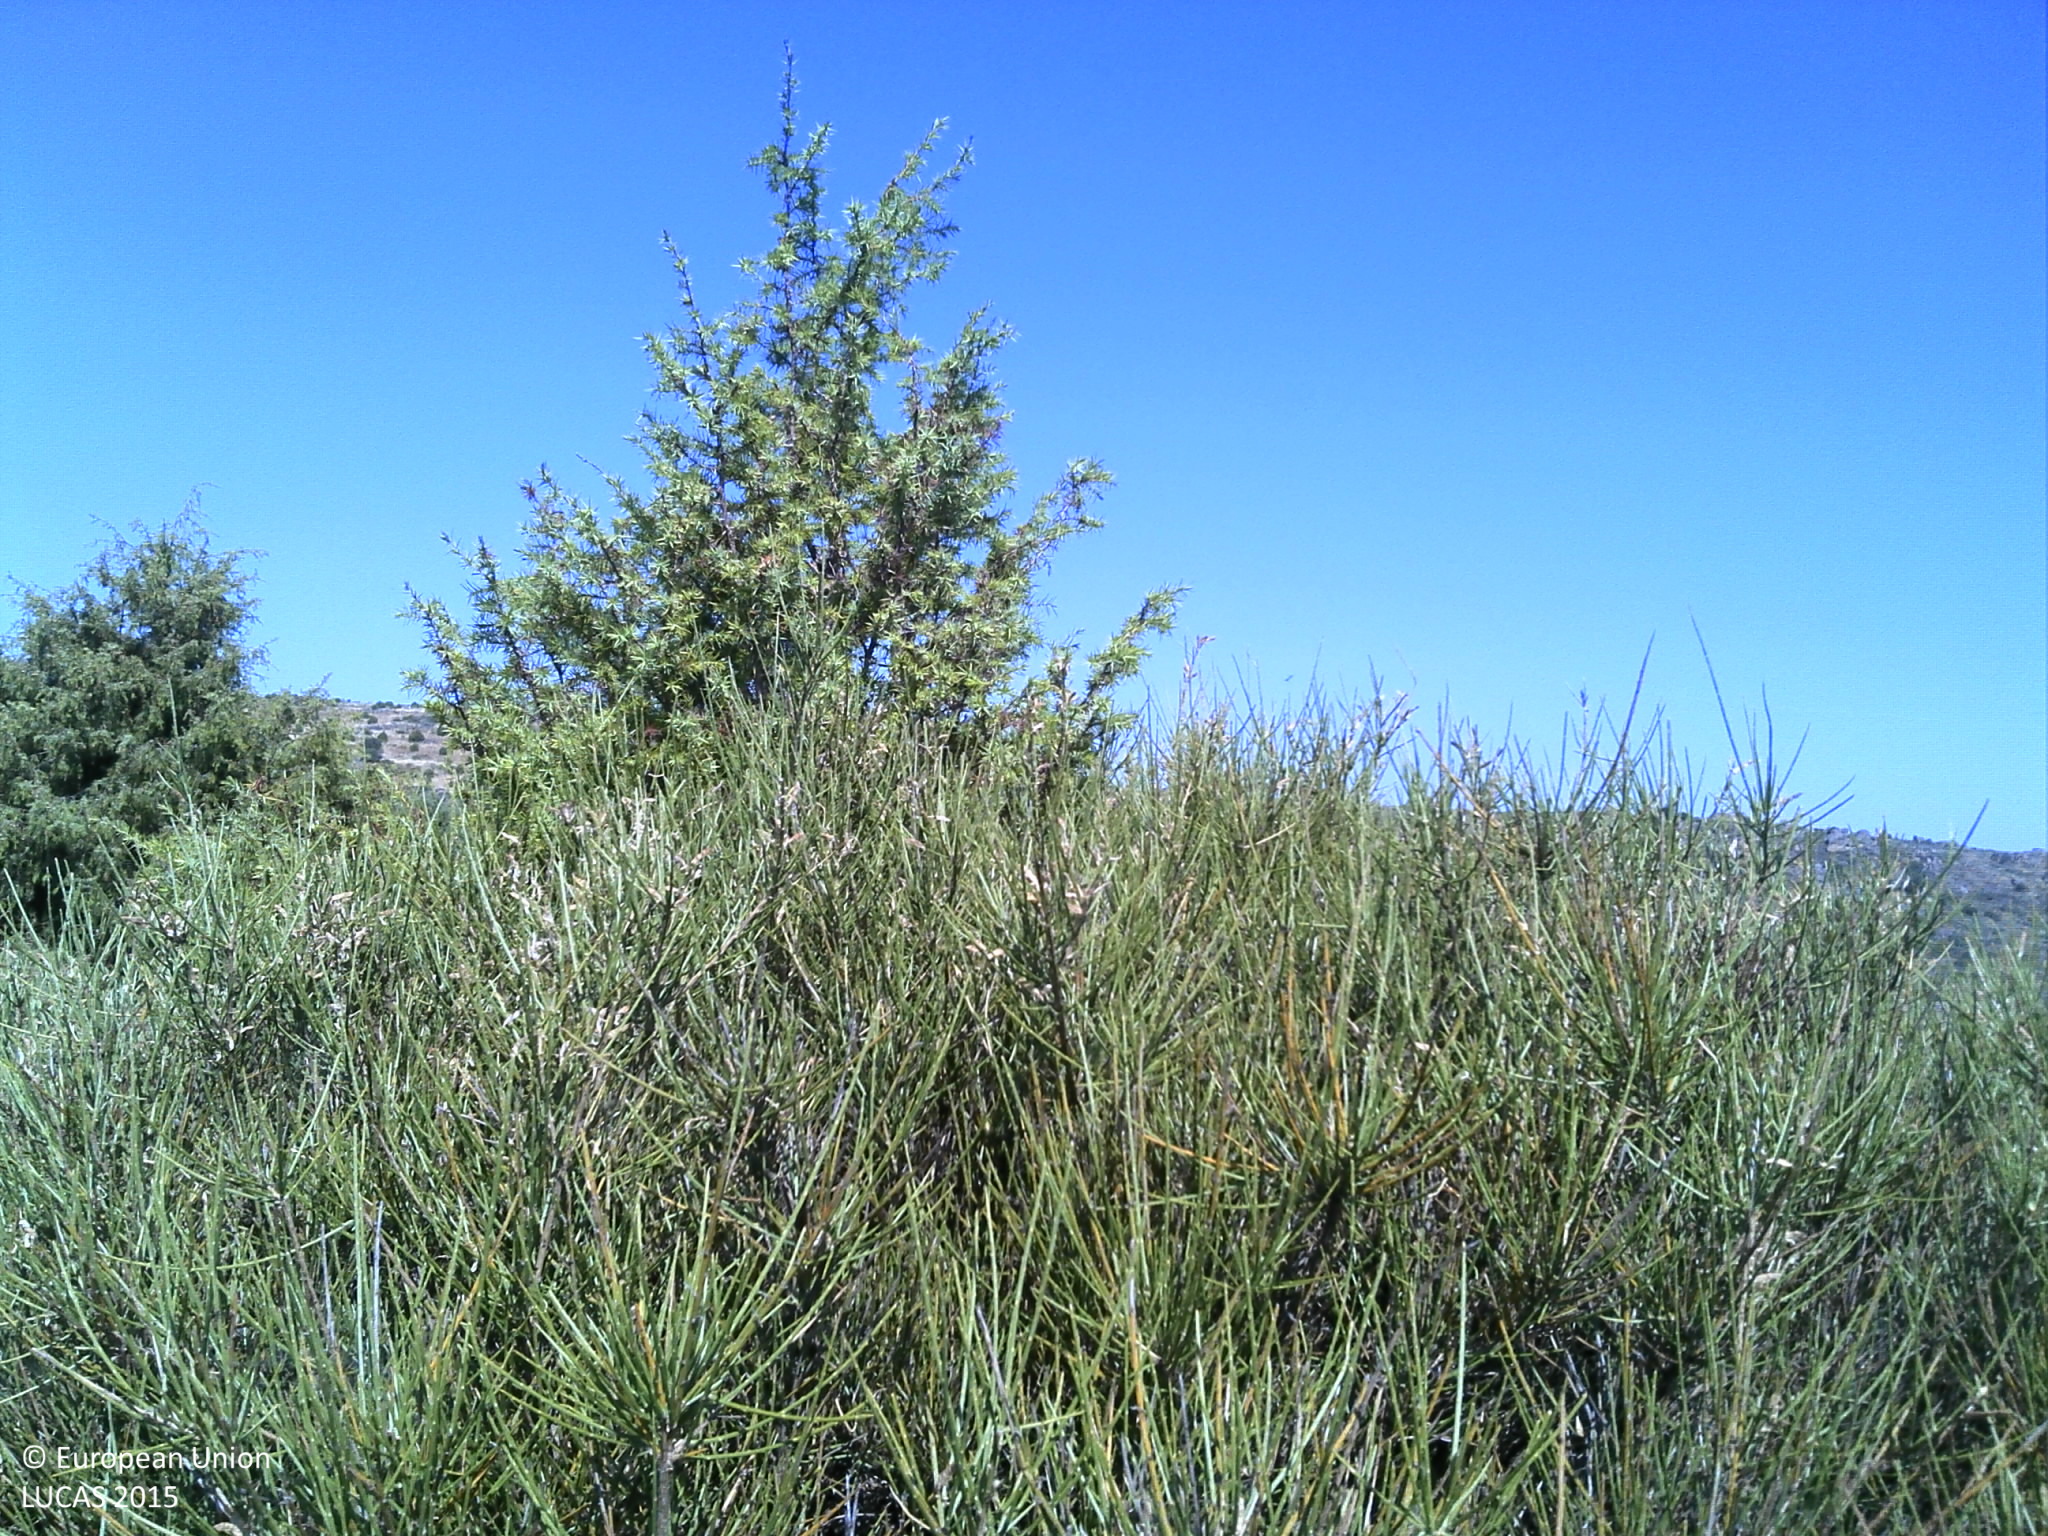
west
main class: Shrubland
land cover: Shrubland with sparse tree cover
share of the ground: > 75 %
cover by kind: shrubs 95 %, coniferous forest trees 5 %
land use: Semi-natural and natural areas not in use
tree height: < 5 m
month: June
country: PT
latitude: 40.9475
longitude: -6.8885
